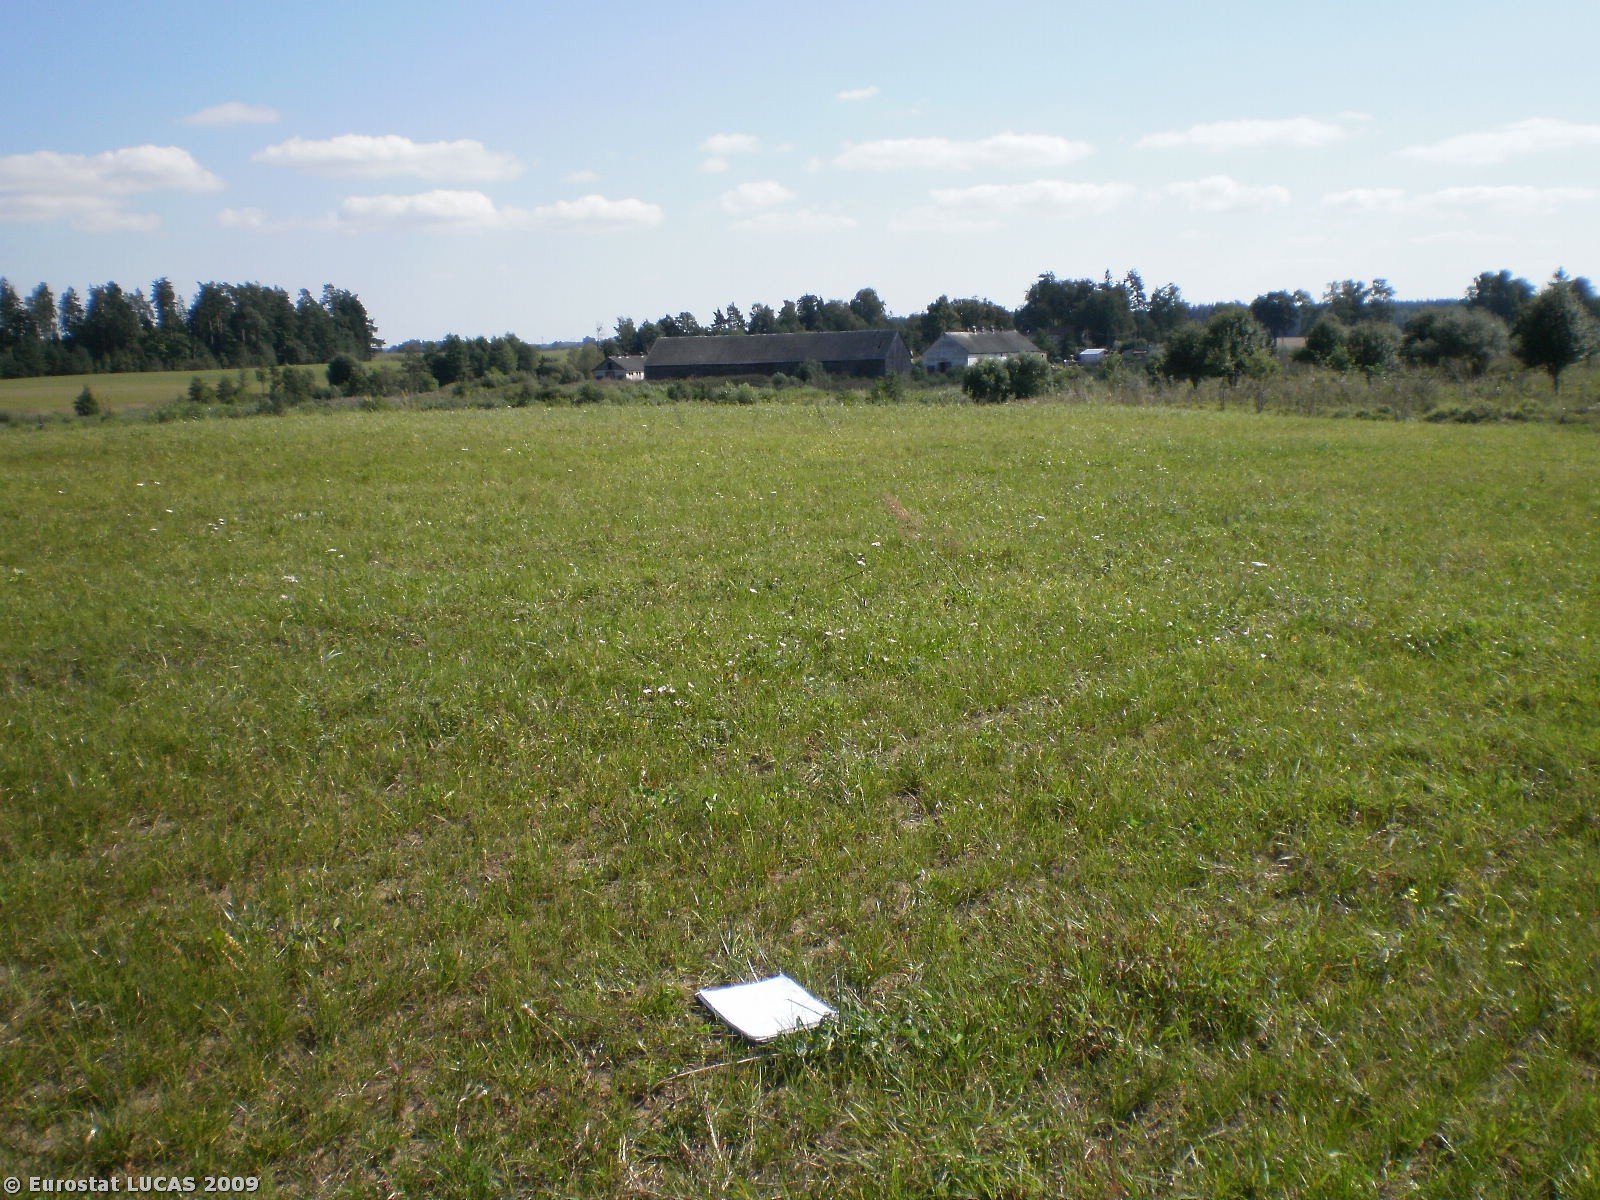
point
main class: Grassland
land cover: Grassland without tree/shrub cover
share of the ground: > 75 %
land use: Agriculture (excluding fallow land and kitchen gardens)
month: August
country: PL
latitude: 54.2059
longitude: 22.1553
